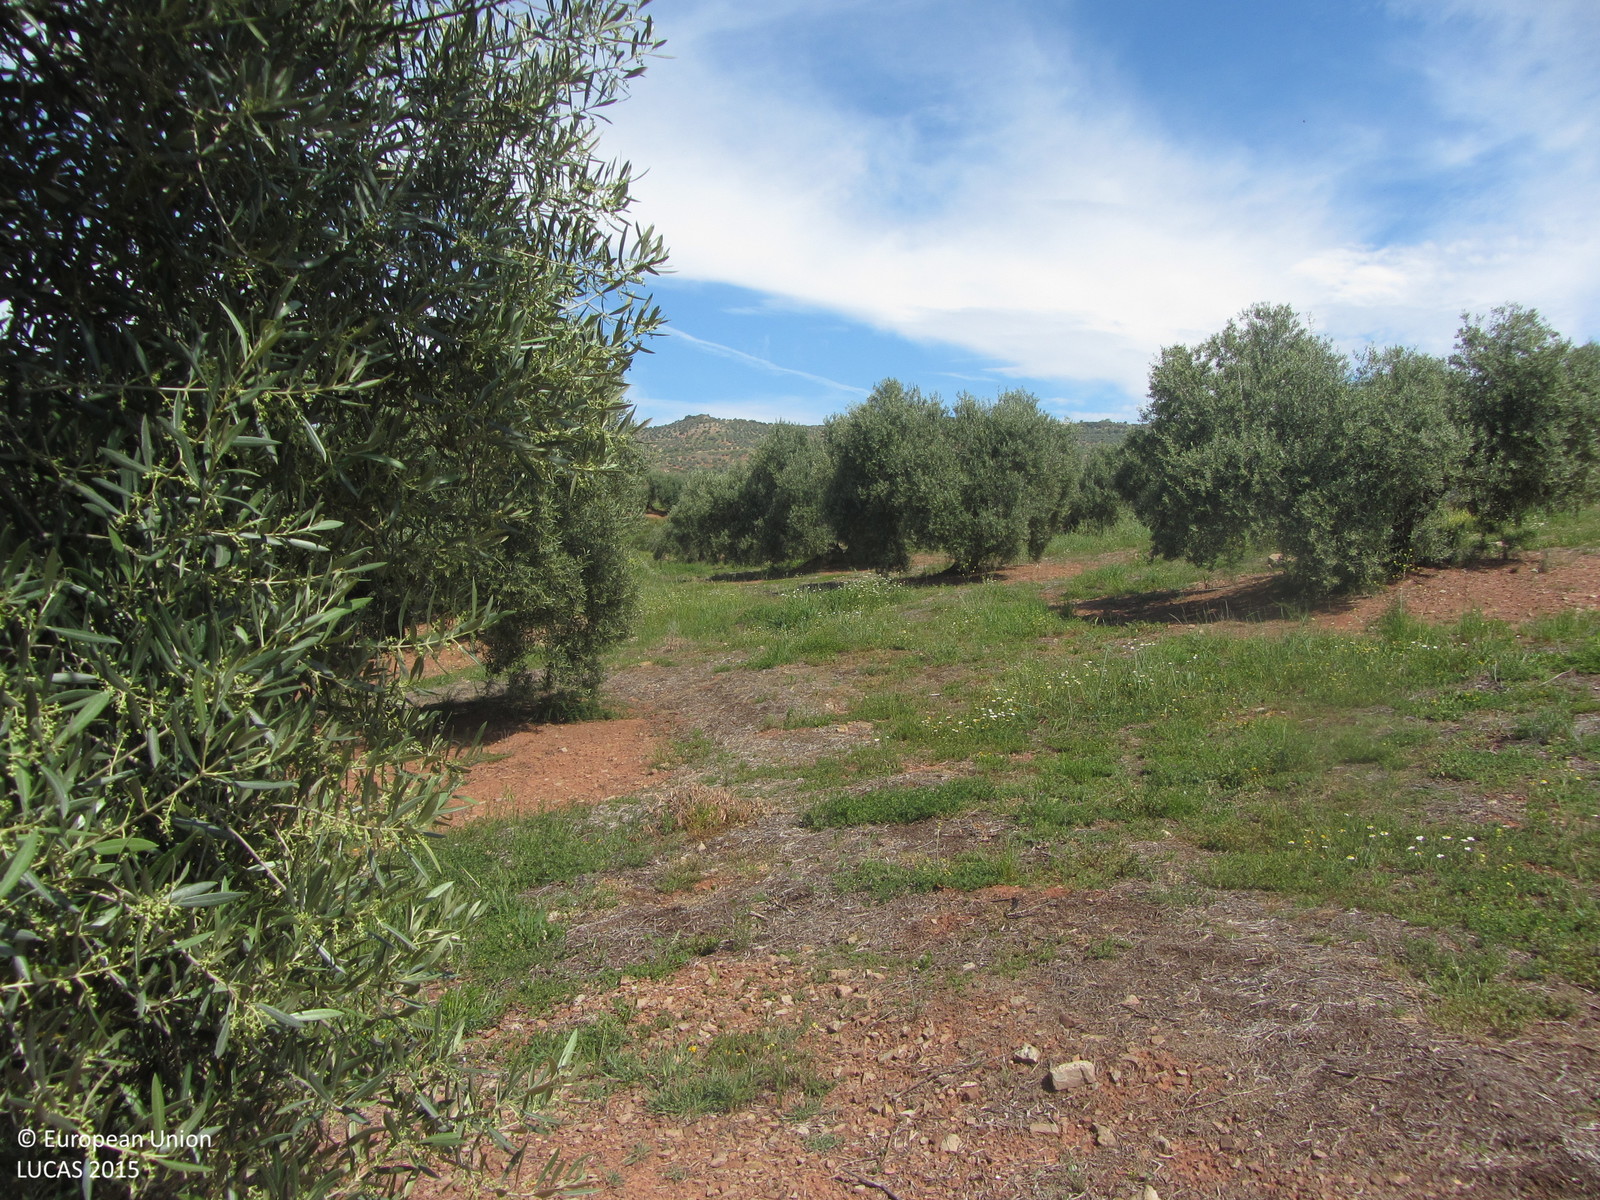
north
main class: Cropland
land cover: Olive groves
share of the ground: 25 - 50 %
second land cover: Spontaneously vegetated surfaces
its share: 25 - 50 %
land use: Agriculture (excluding fallow land and kitchen gardens)
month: May
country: ES
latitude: 38.2931
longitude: -3.0468
